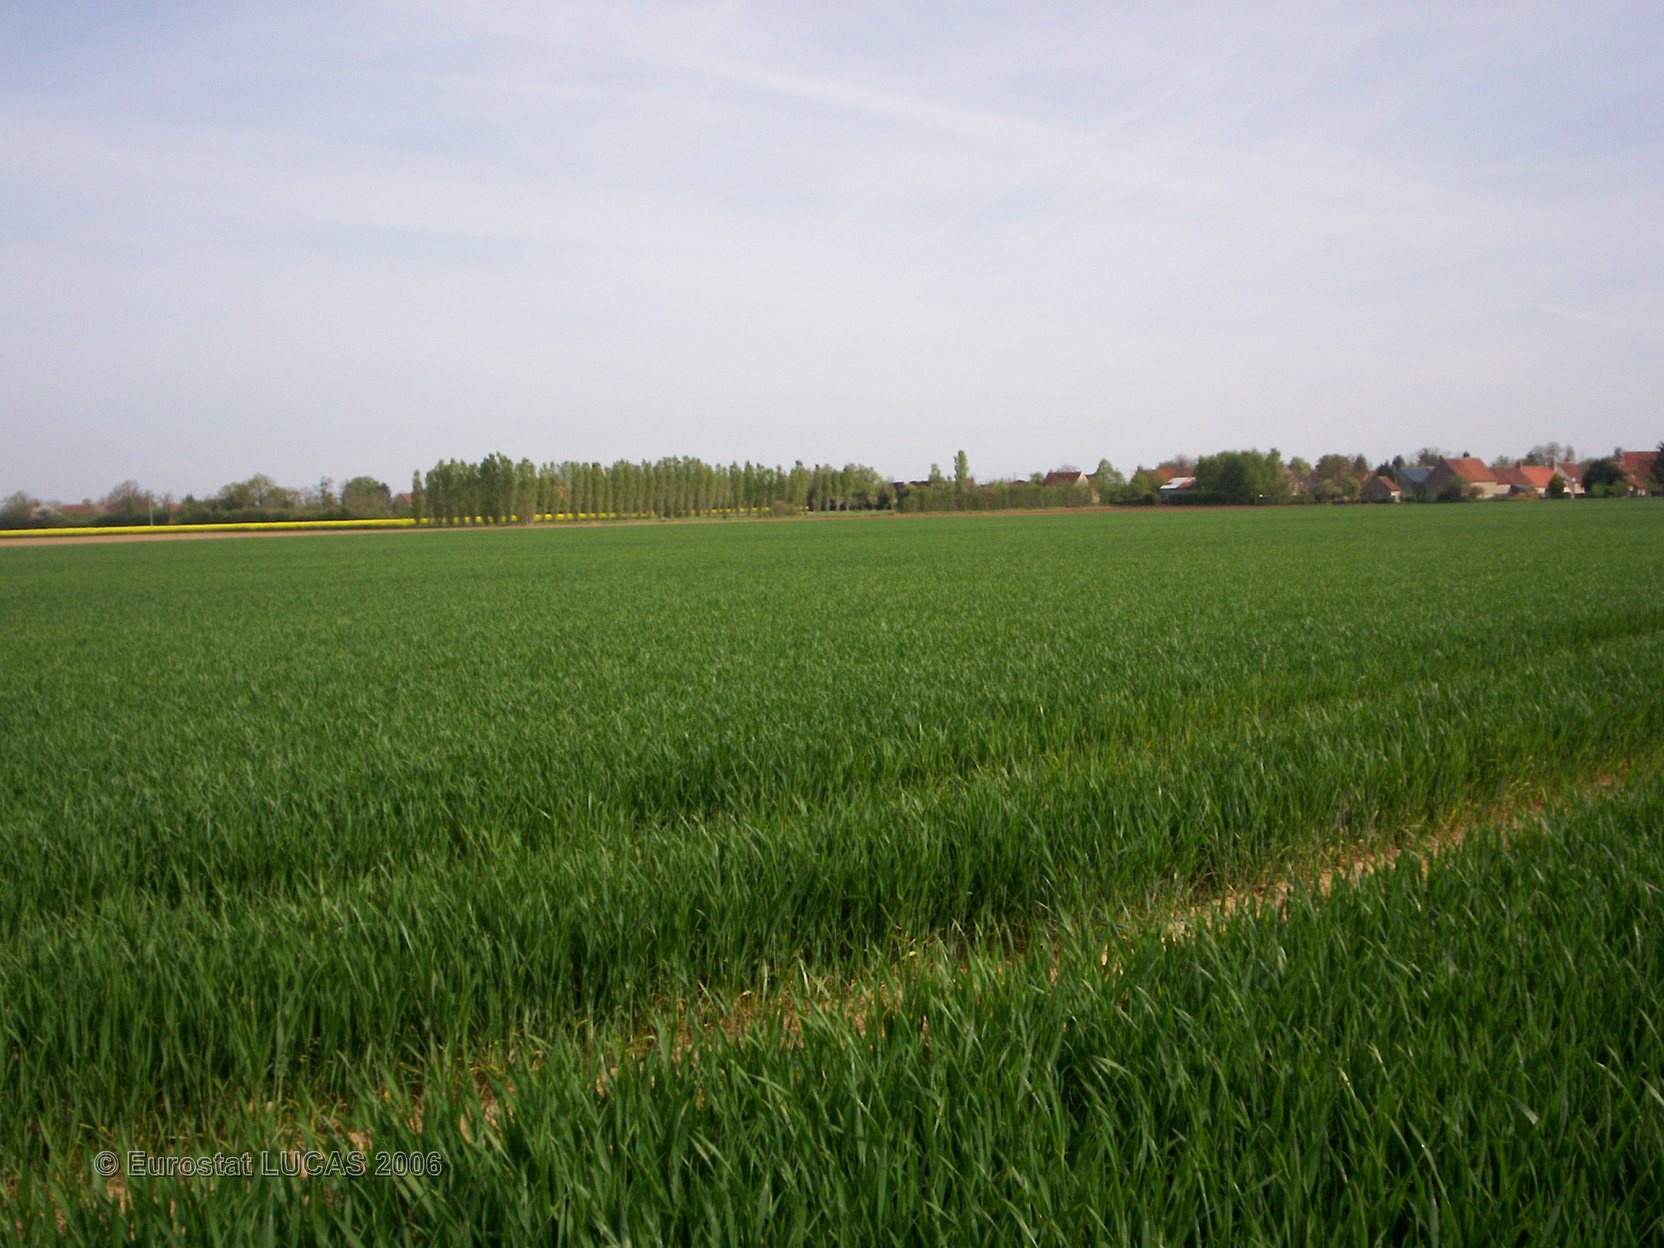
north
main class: Cropland
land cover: Common wheat
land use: Agriculture (excluding fallow land and kitchen gardens)
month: May
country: FR
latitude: 47.2639
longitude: 3.0566
